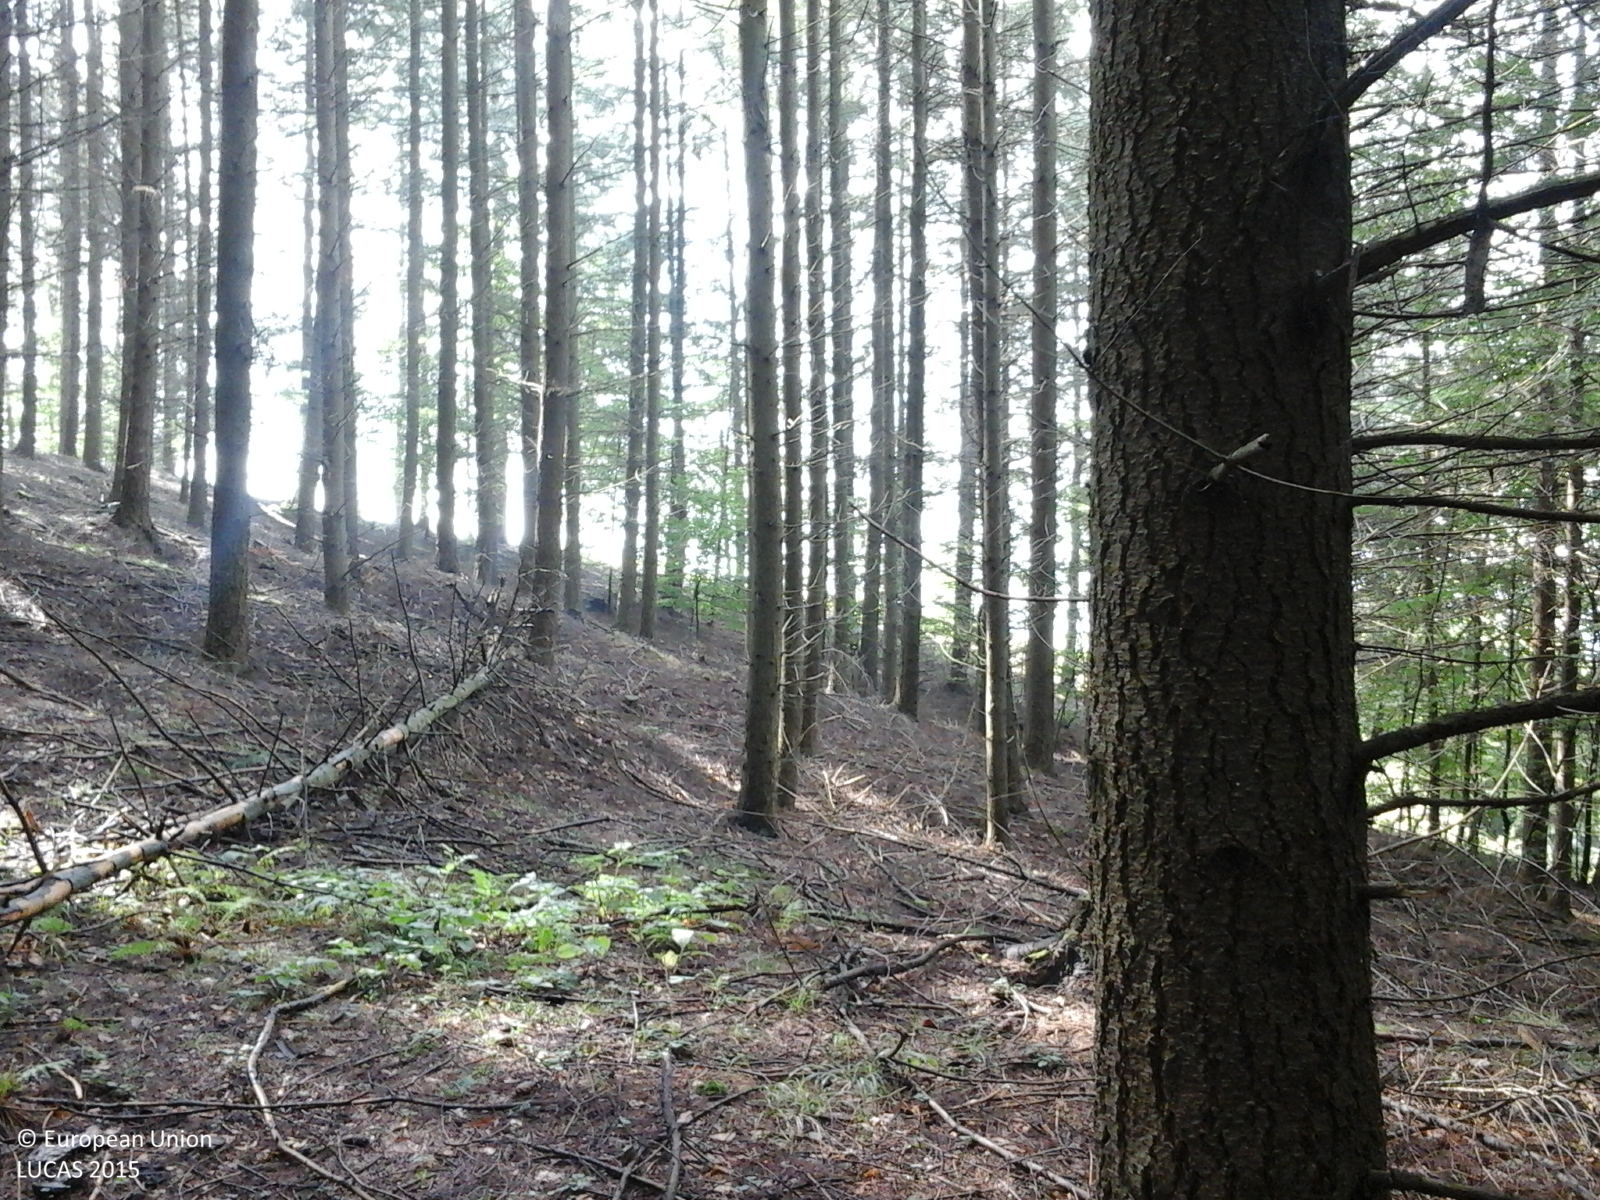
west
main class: Woodland
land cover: Pine dominated mixed woodland
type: alpine coniferous forest
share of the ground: > 75 %
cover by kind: coniferous forest trees 75 %, broadleaved forest trees 25 %
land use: Forestry
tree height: > 5 m
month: September
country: RO
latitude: 46.9443
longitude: 22.6552
